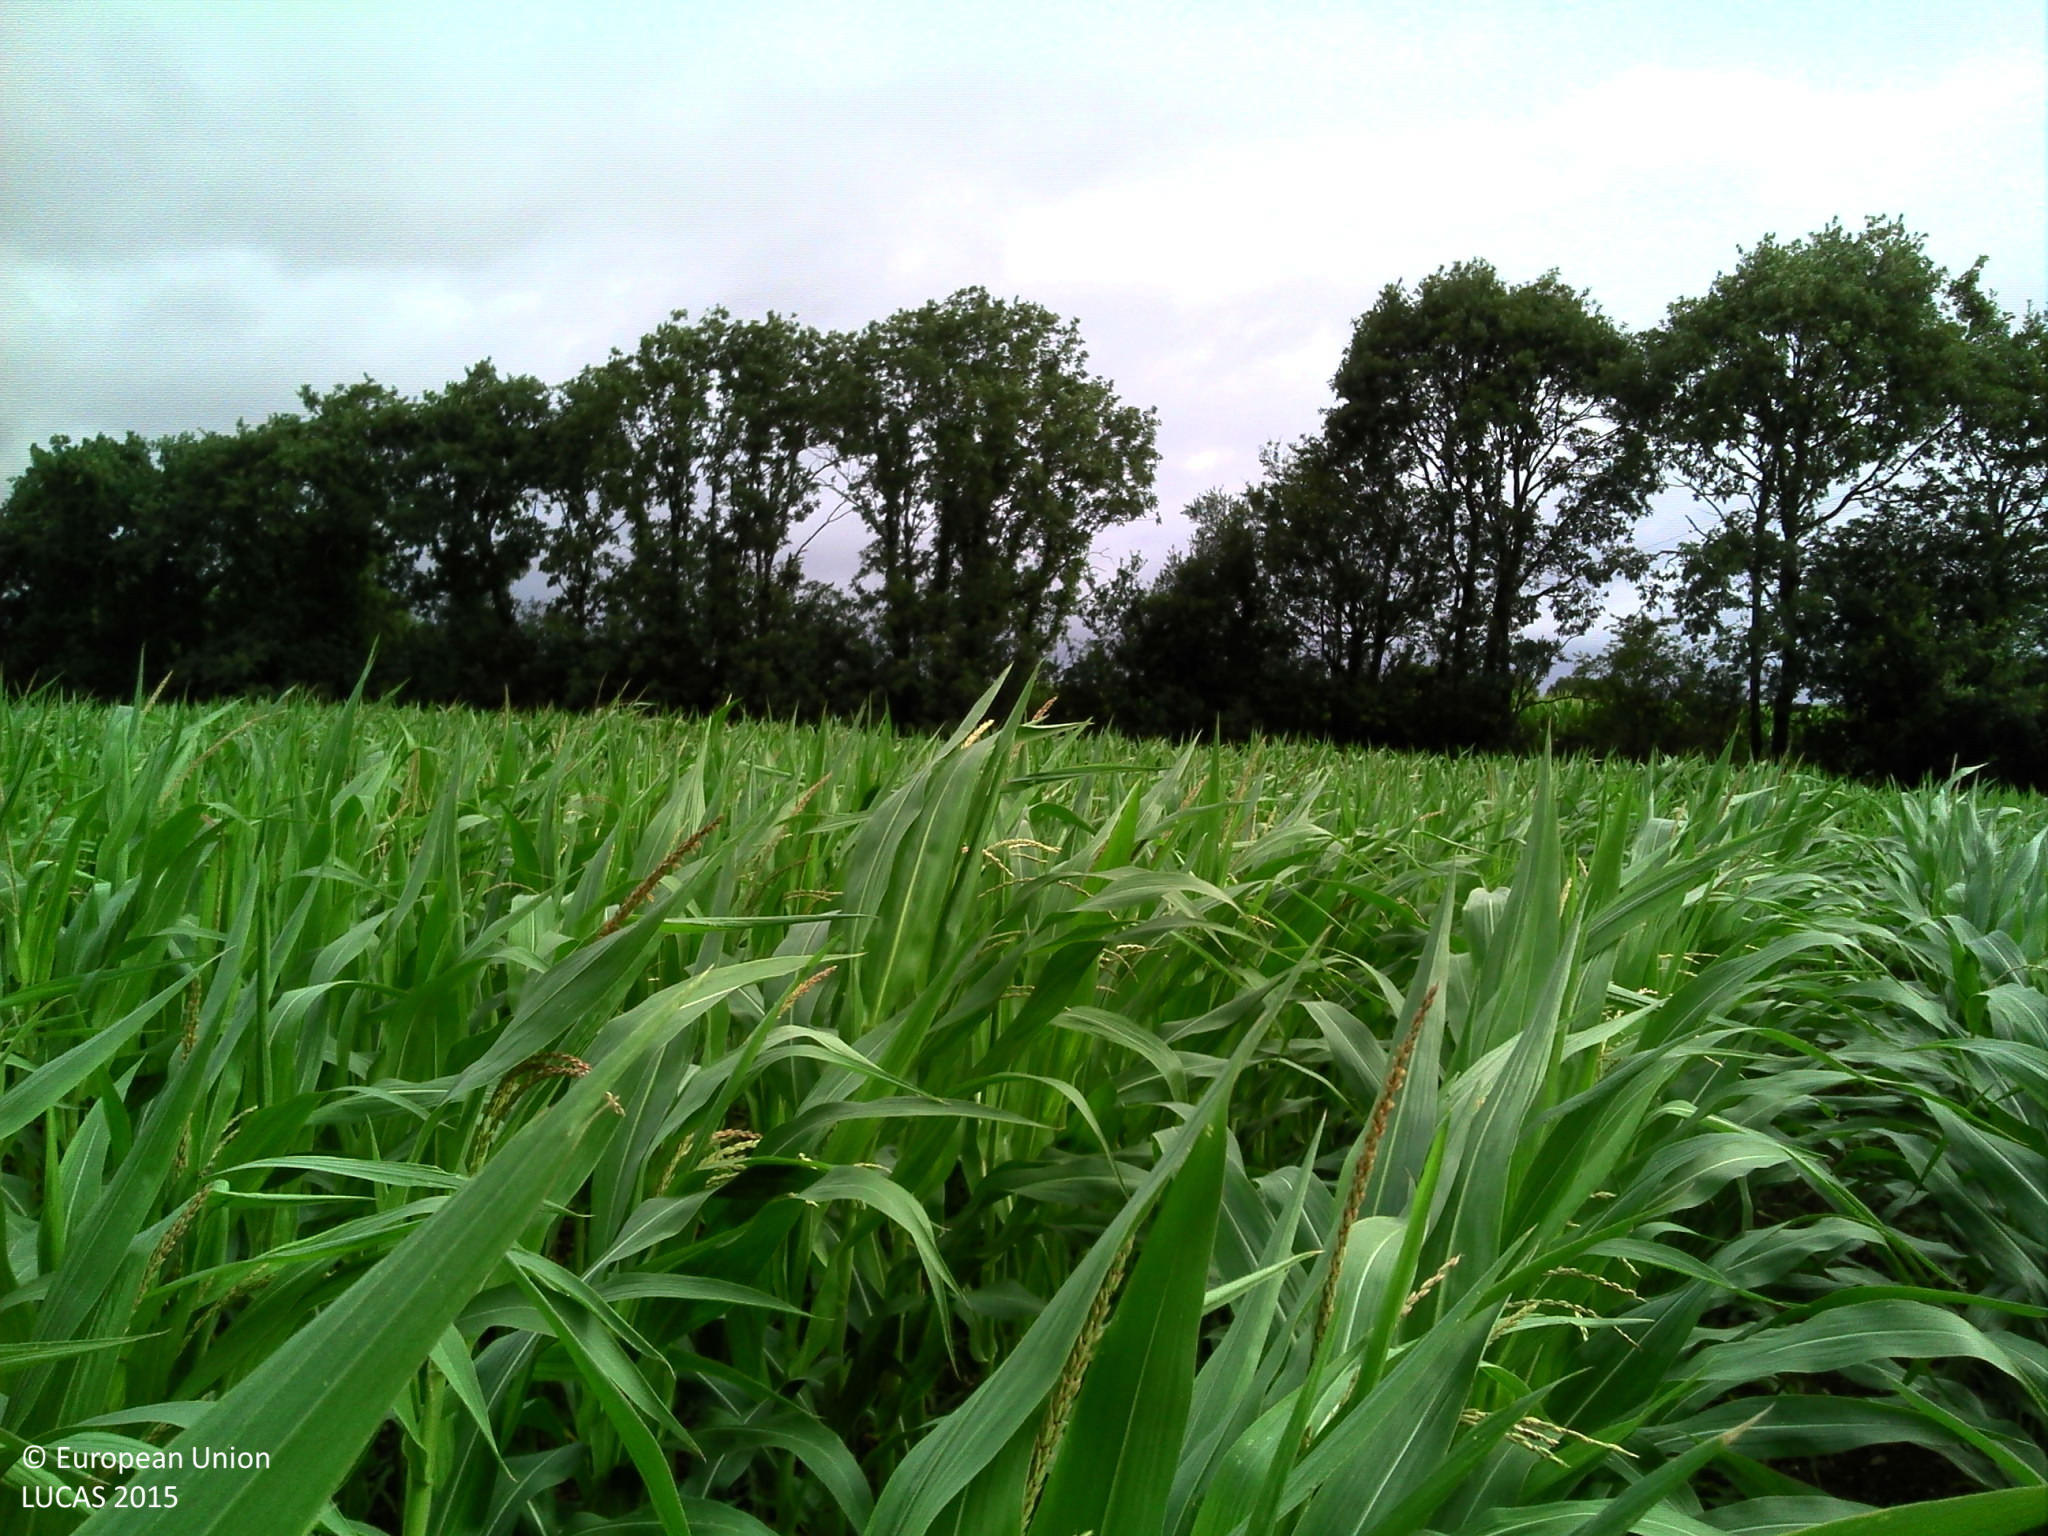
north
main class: Cropland
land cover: Maize
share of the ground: 50 - 75 %
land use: Agriculture (excluding fallow land and kitchen gardens)
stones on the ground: 10 - 25 %
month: July
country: FR
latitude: 47.4557
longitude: -1.8389
